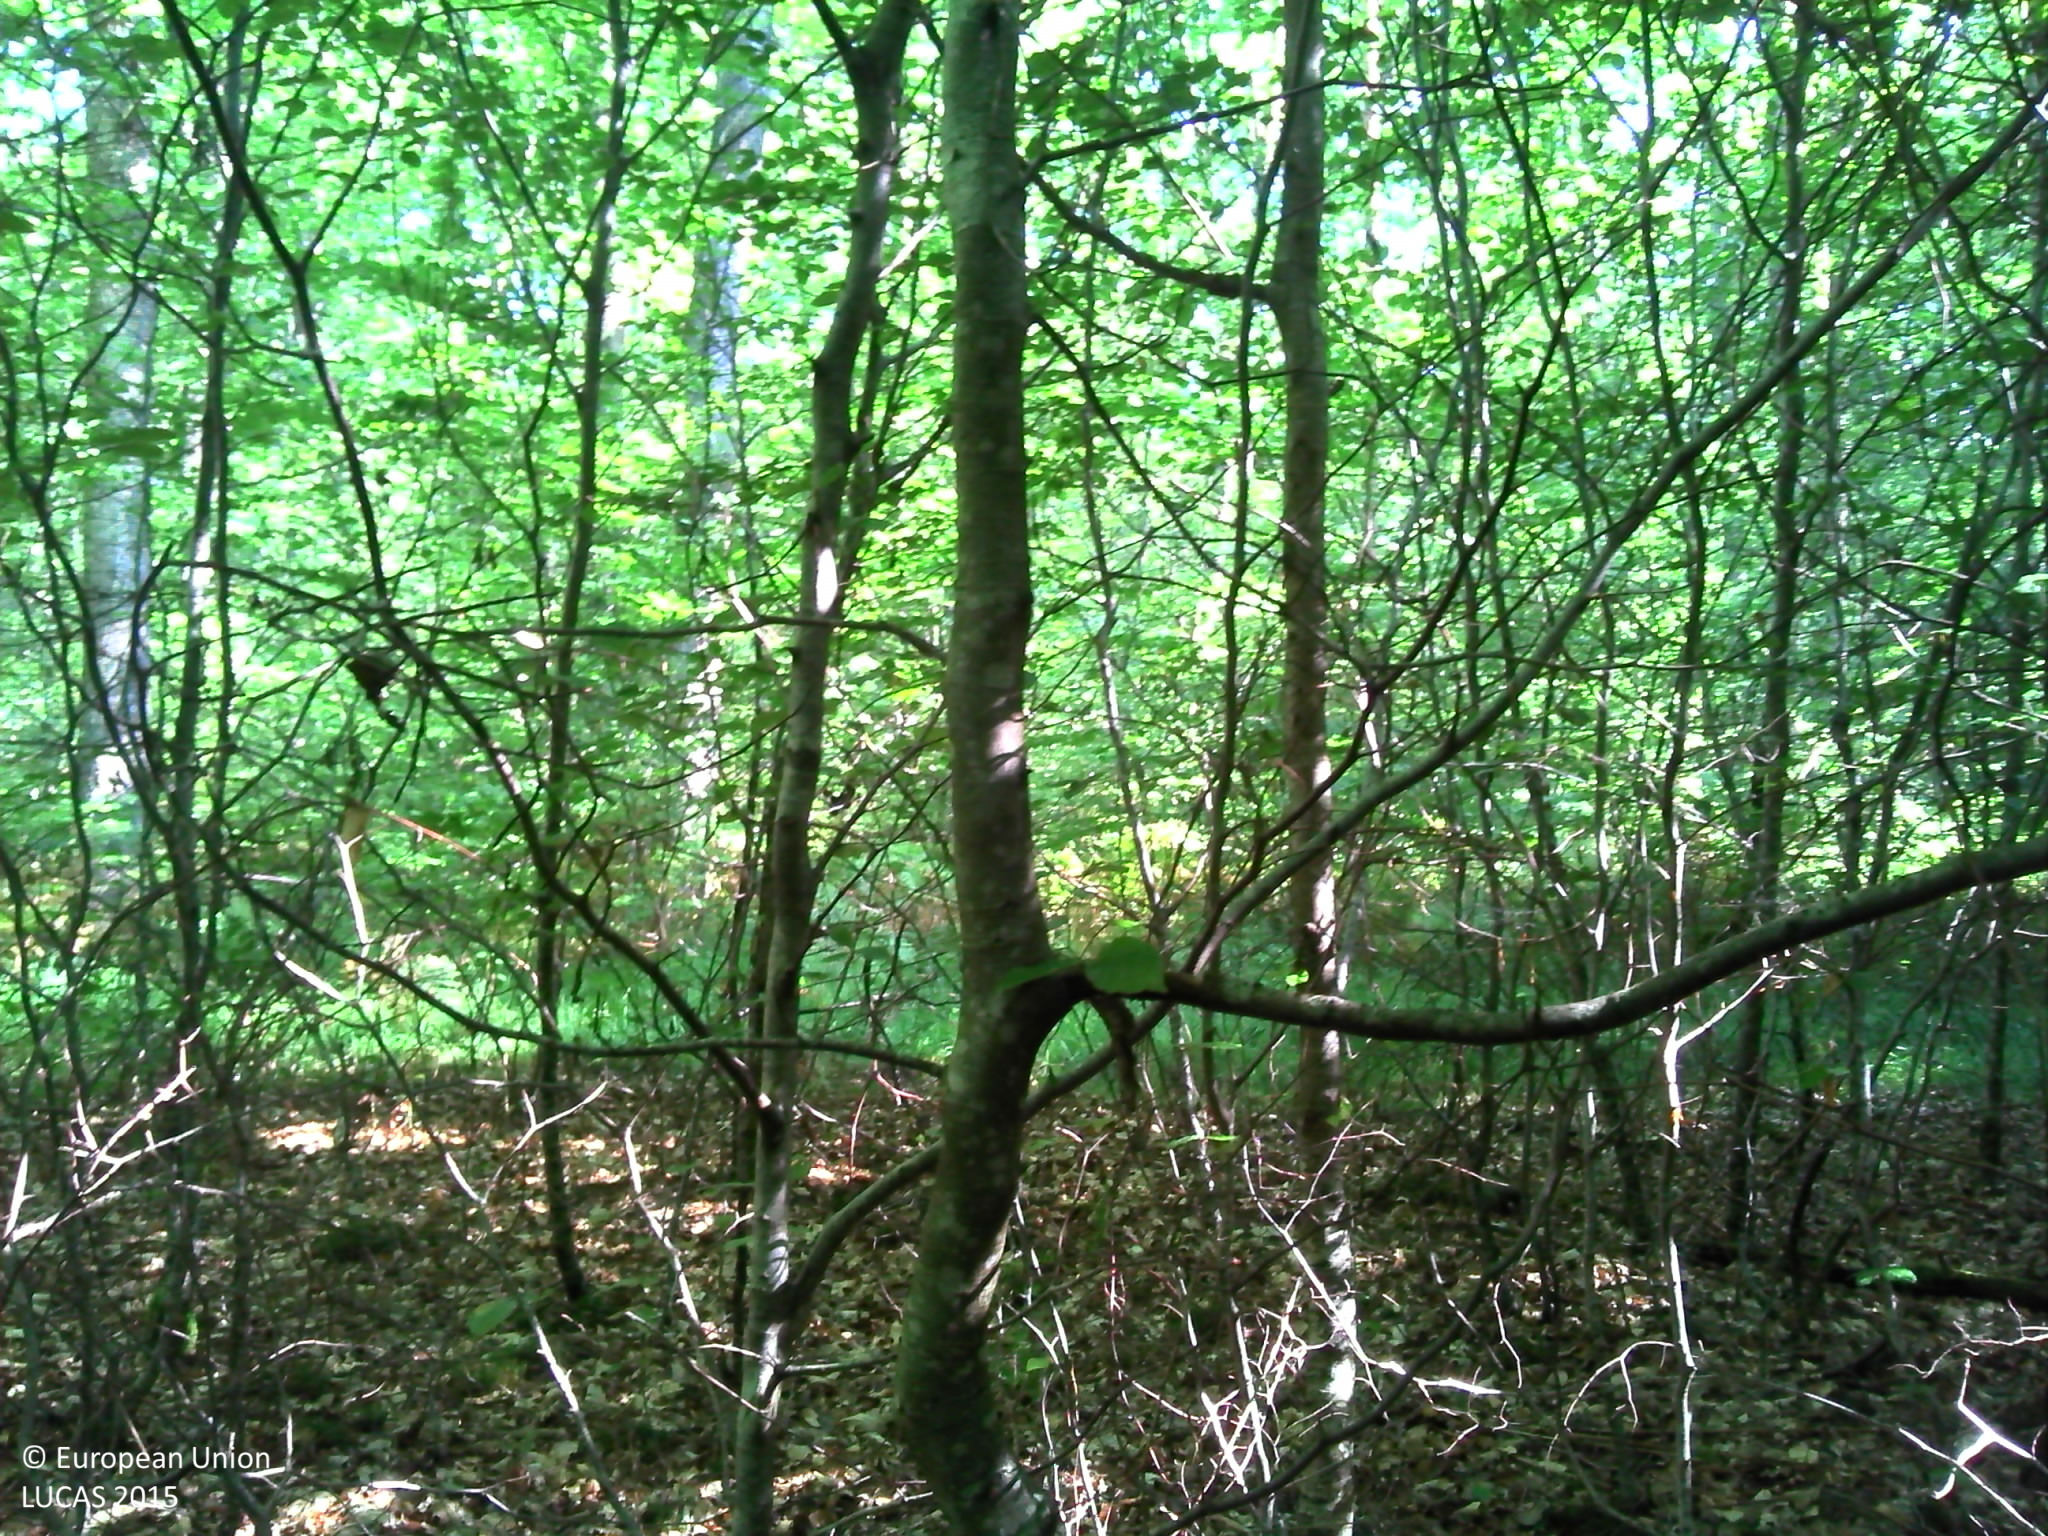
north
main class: Woodland
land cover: Broadleaved woodland
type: beech forest
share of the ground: > 75 %
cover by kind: broadleaved forest trees 90 %, herbaceous plants 5 %, lichens and mosses 5 %
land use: Forestry
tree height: > 5 m
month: August
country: FR
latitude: 46.6470
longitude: 2.7443
